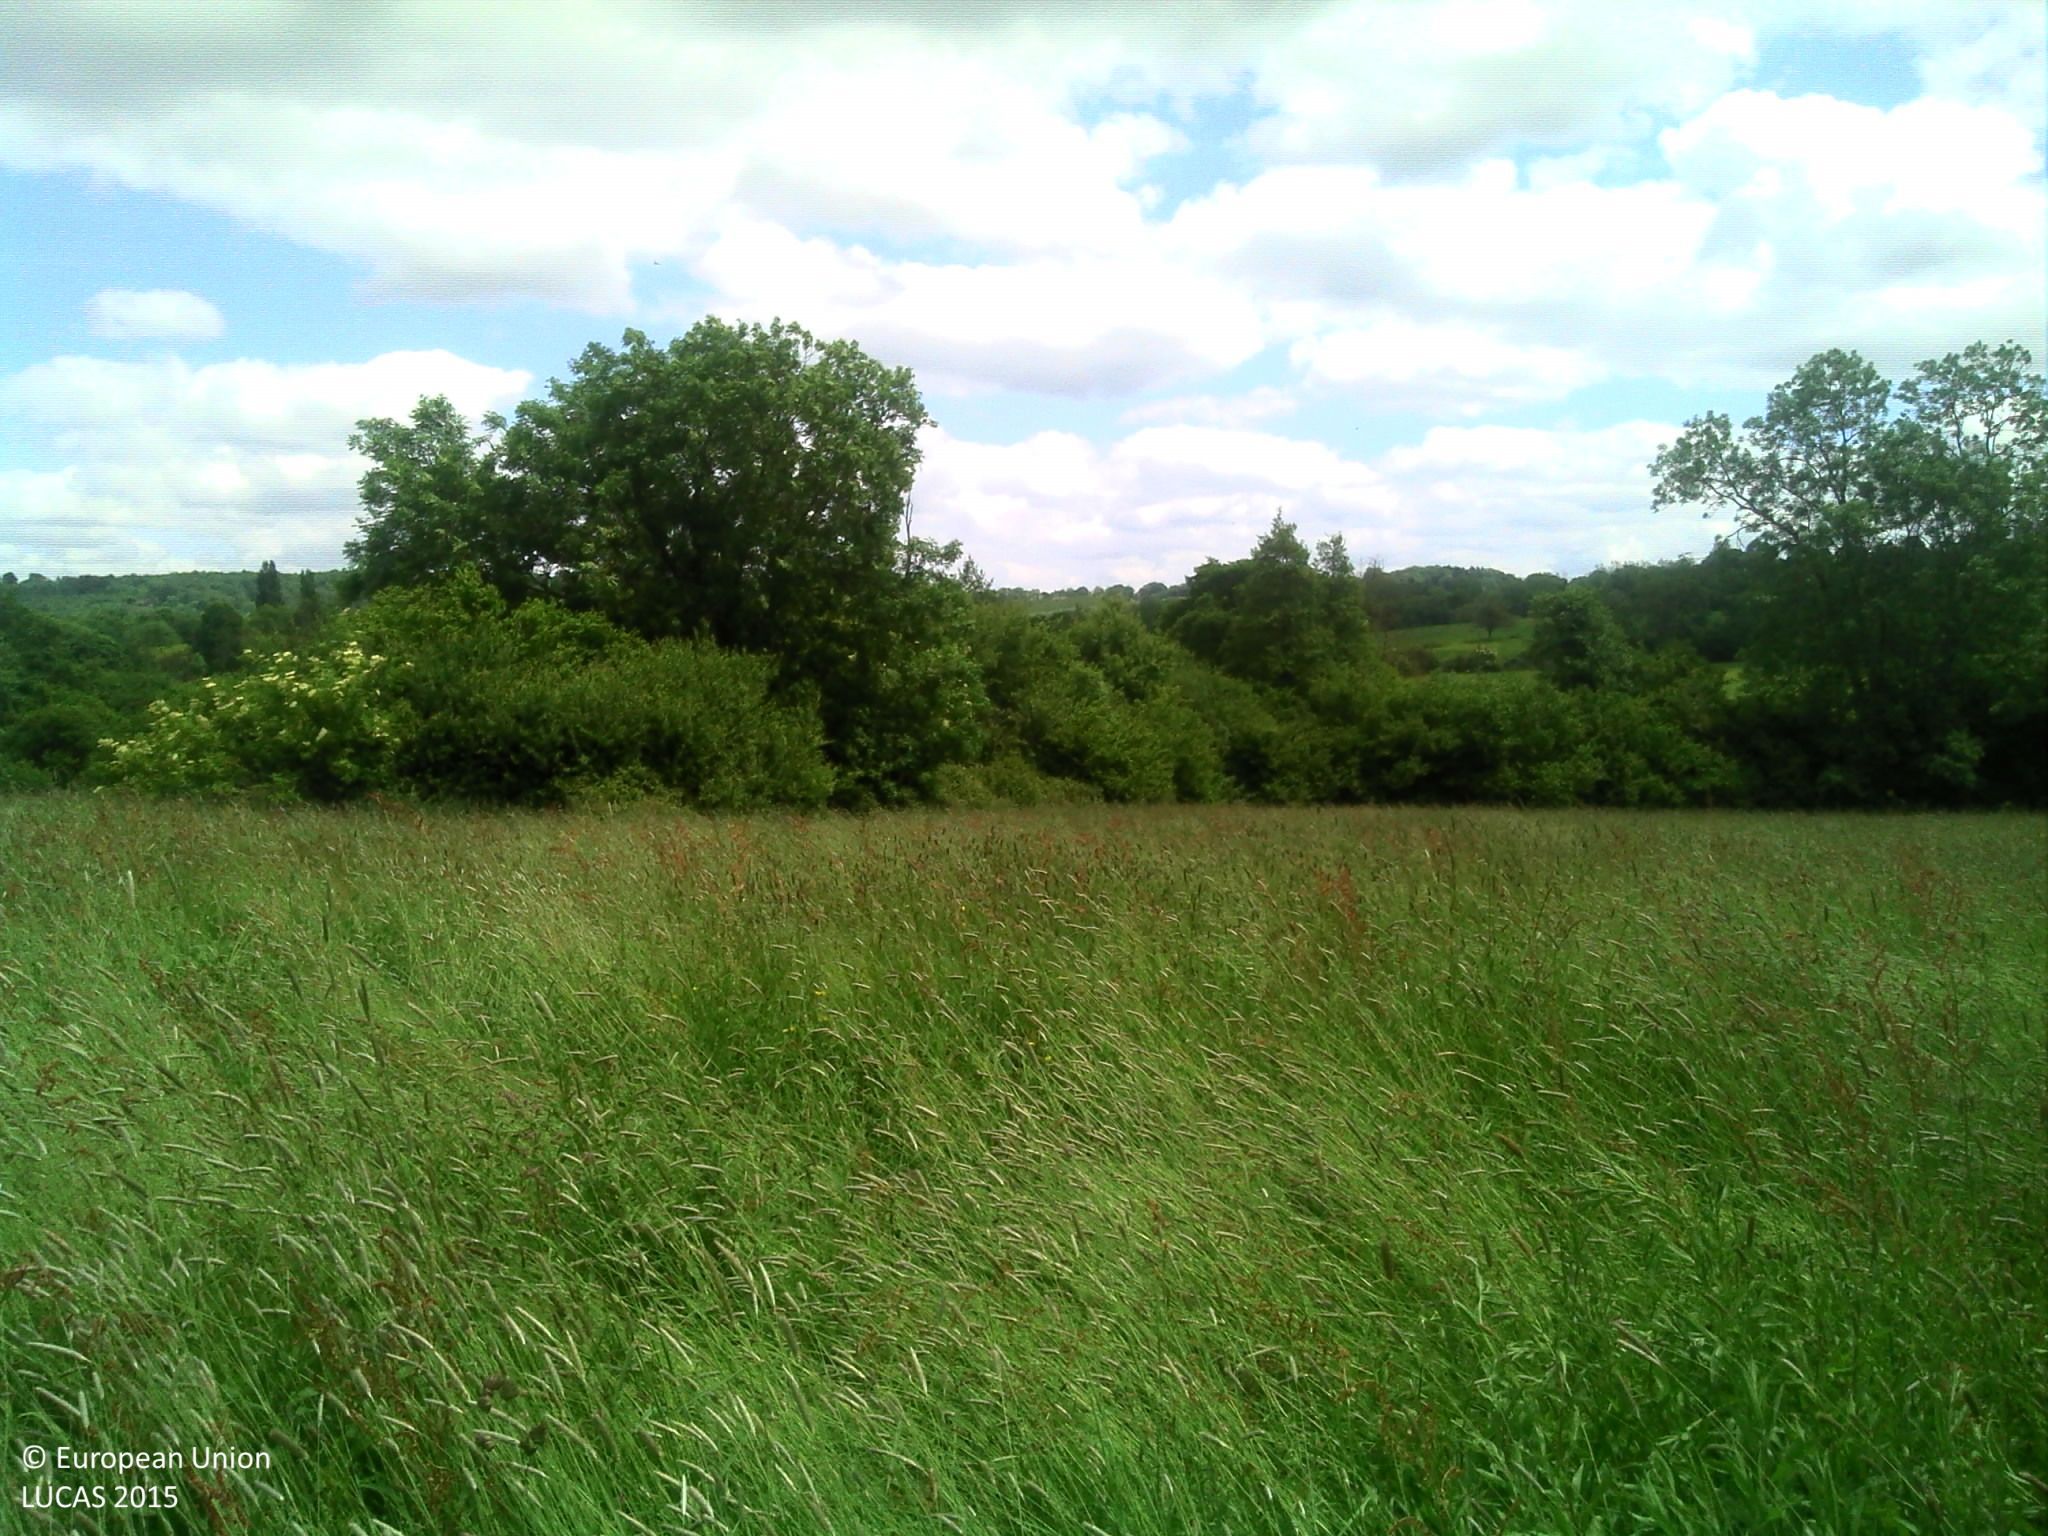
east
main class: Grassland
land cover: Grassland without tree/shrub cover
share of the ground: > 75 %
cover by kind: herbaceous plants 95 %
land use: Agriculture (excluding fallow land and kitchen gardens)
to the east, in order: Grassland without tree/shrub cover; Broadleaved woodland; Rivers and streams; Fences; Grassland without tree/shrub cover; Electric lines; Grassland without tree/shrub cover
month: June
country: FR
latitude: 48.8989
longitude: 0.0804
